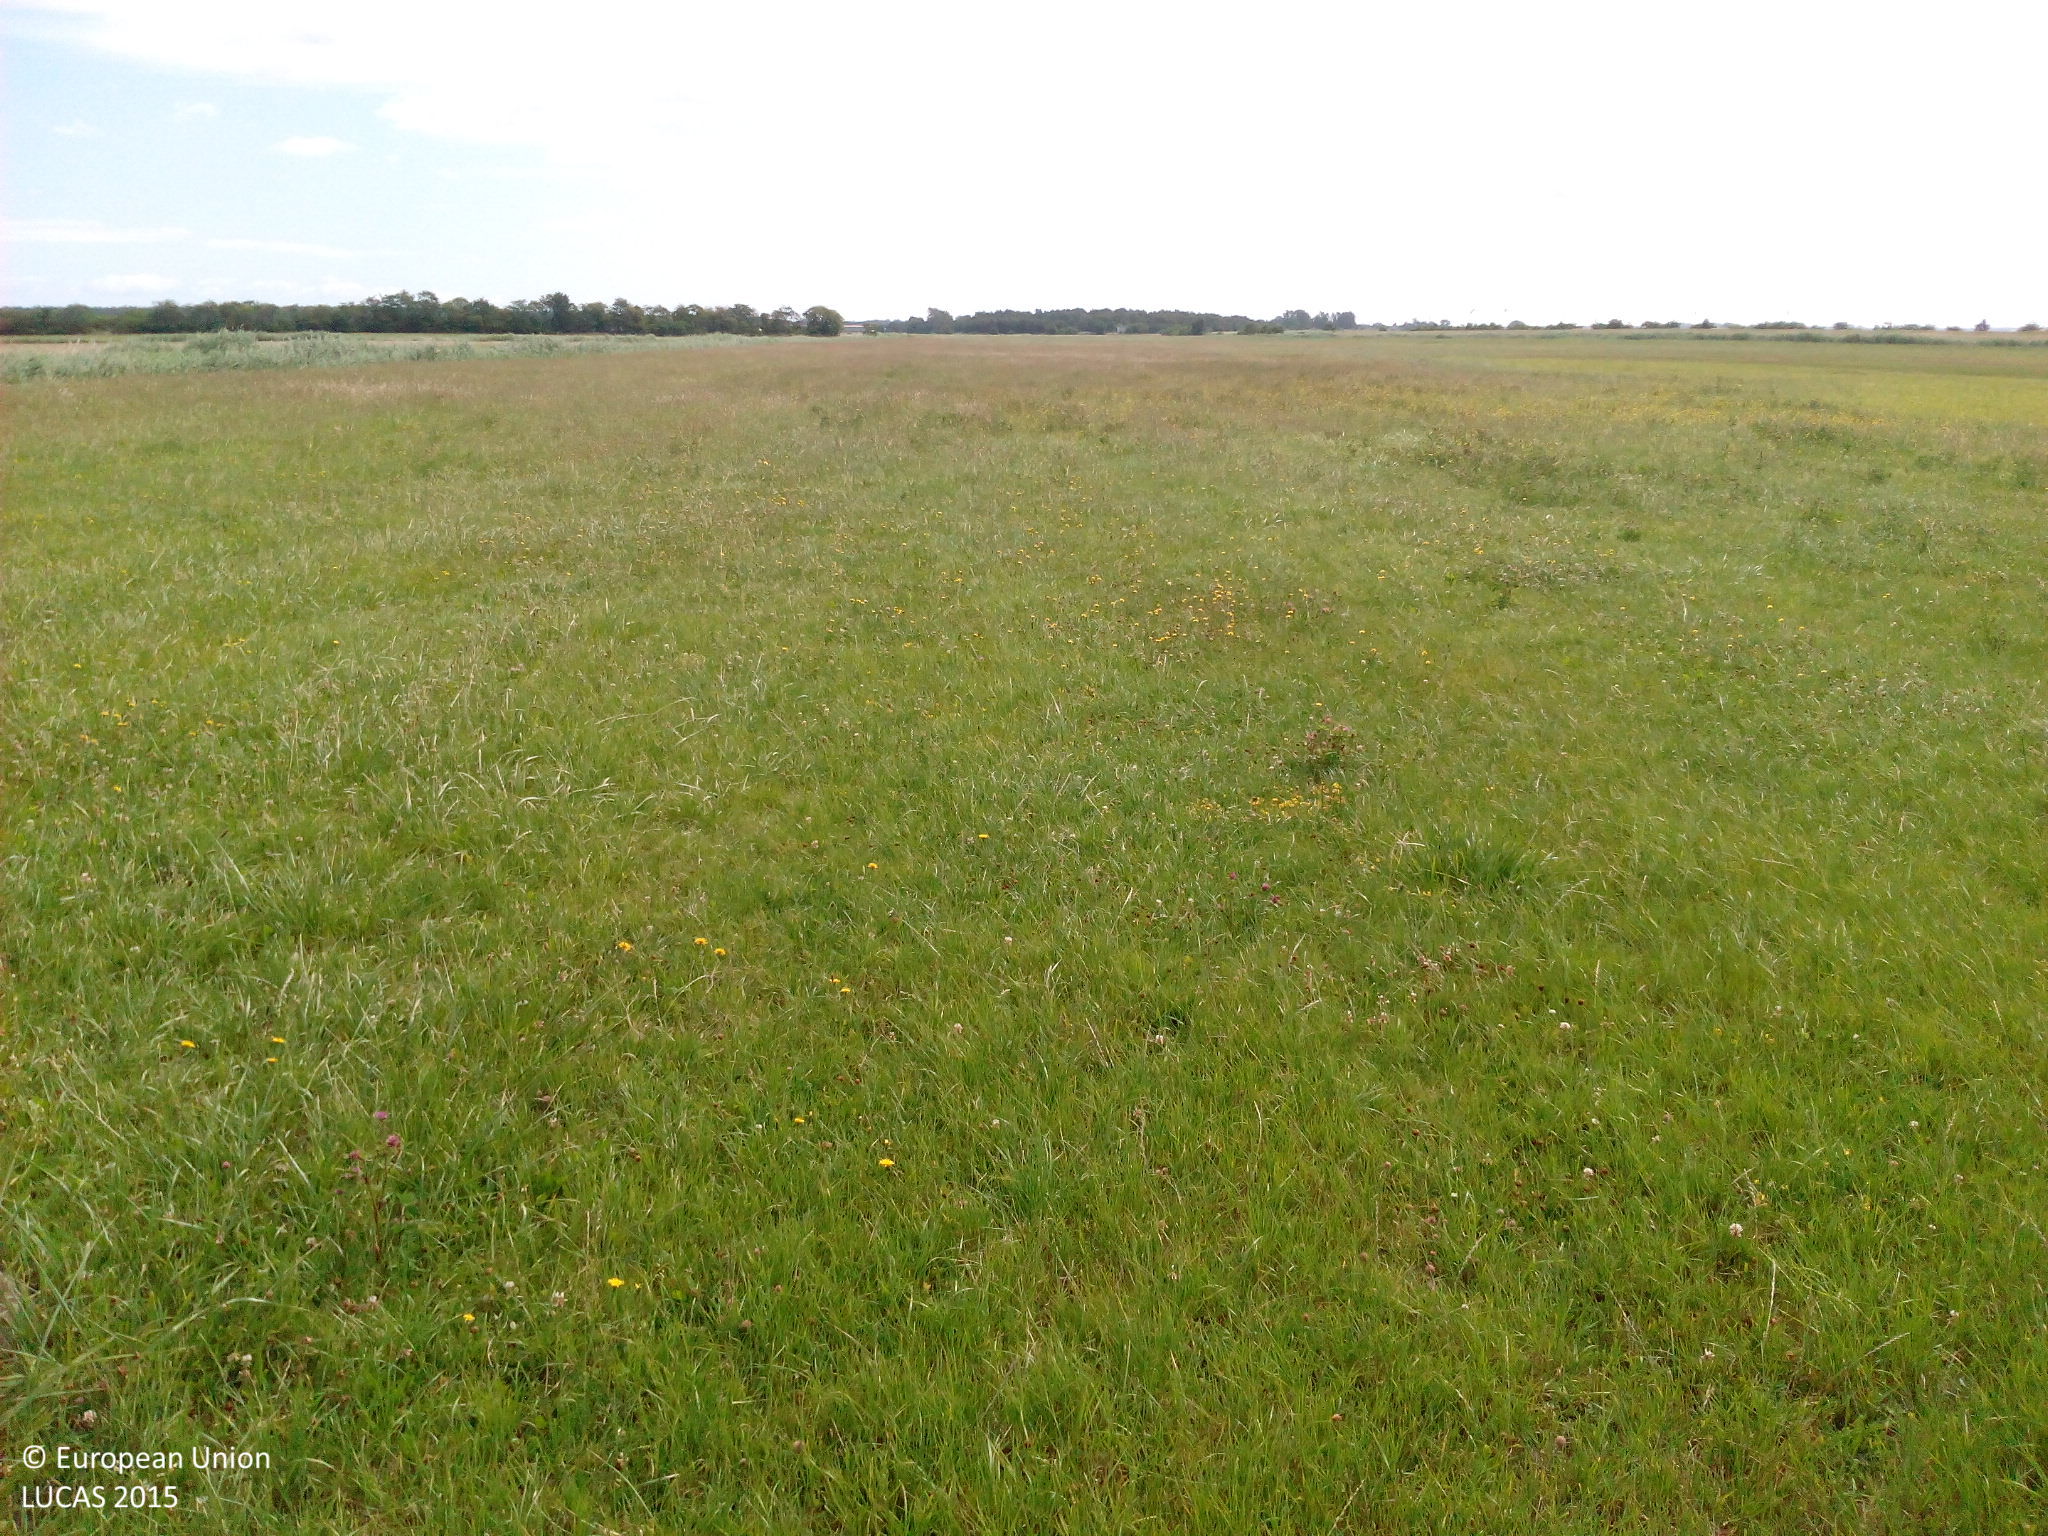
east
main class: Grassland
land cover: Grassland without tree/shrub cover
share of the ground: > 75 %
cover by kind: herbaceous plants 100 %
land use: Agriculture (excluding fallow land and kitchen gardens)
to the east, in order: Grassland without tree/shrub cover
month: July
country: DE
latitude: 54.3836
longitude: 12.4779
